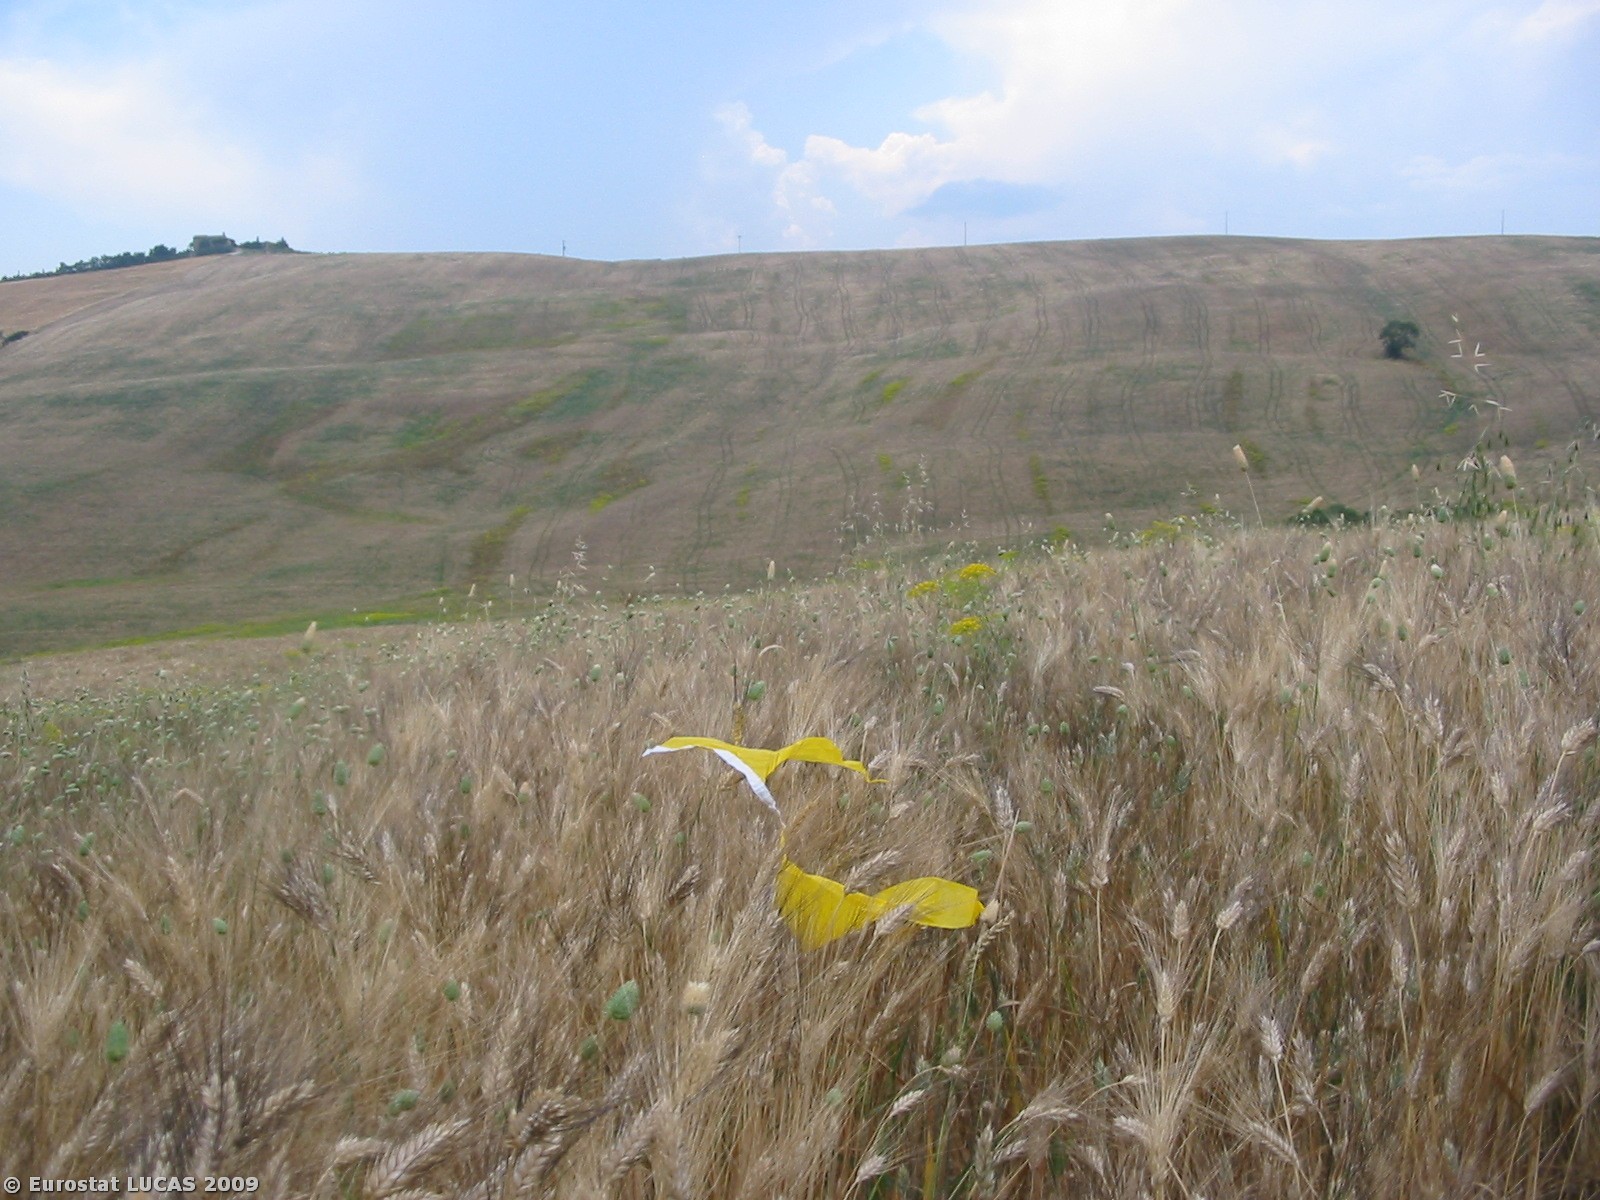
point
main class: Cropland
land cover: Durum wheat
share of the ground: > 75 %
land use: Agriculture (excluding fallow land and kitchen gardens)
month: June
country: IT
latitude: 43.1105
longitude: 11.6295
